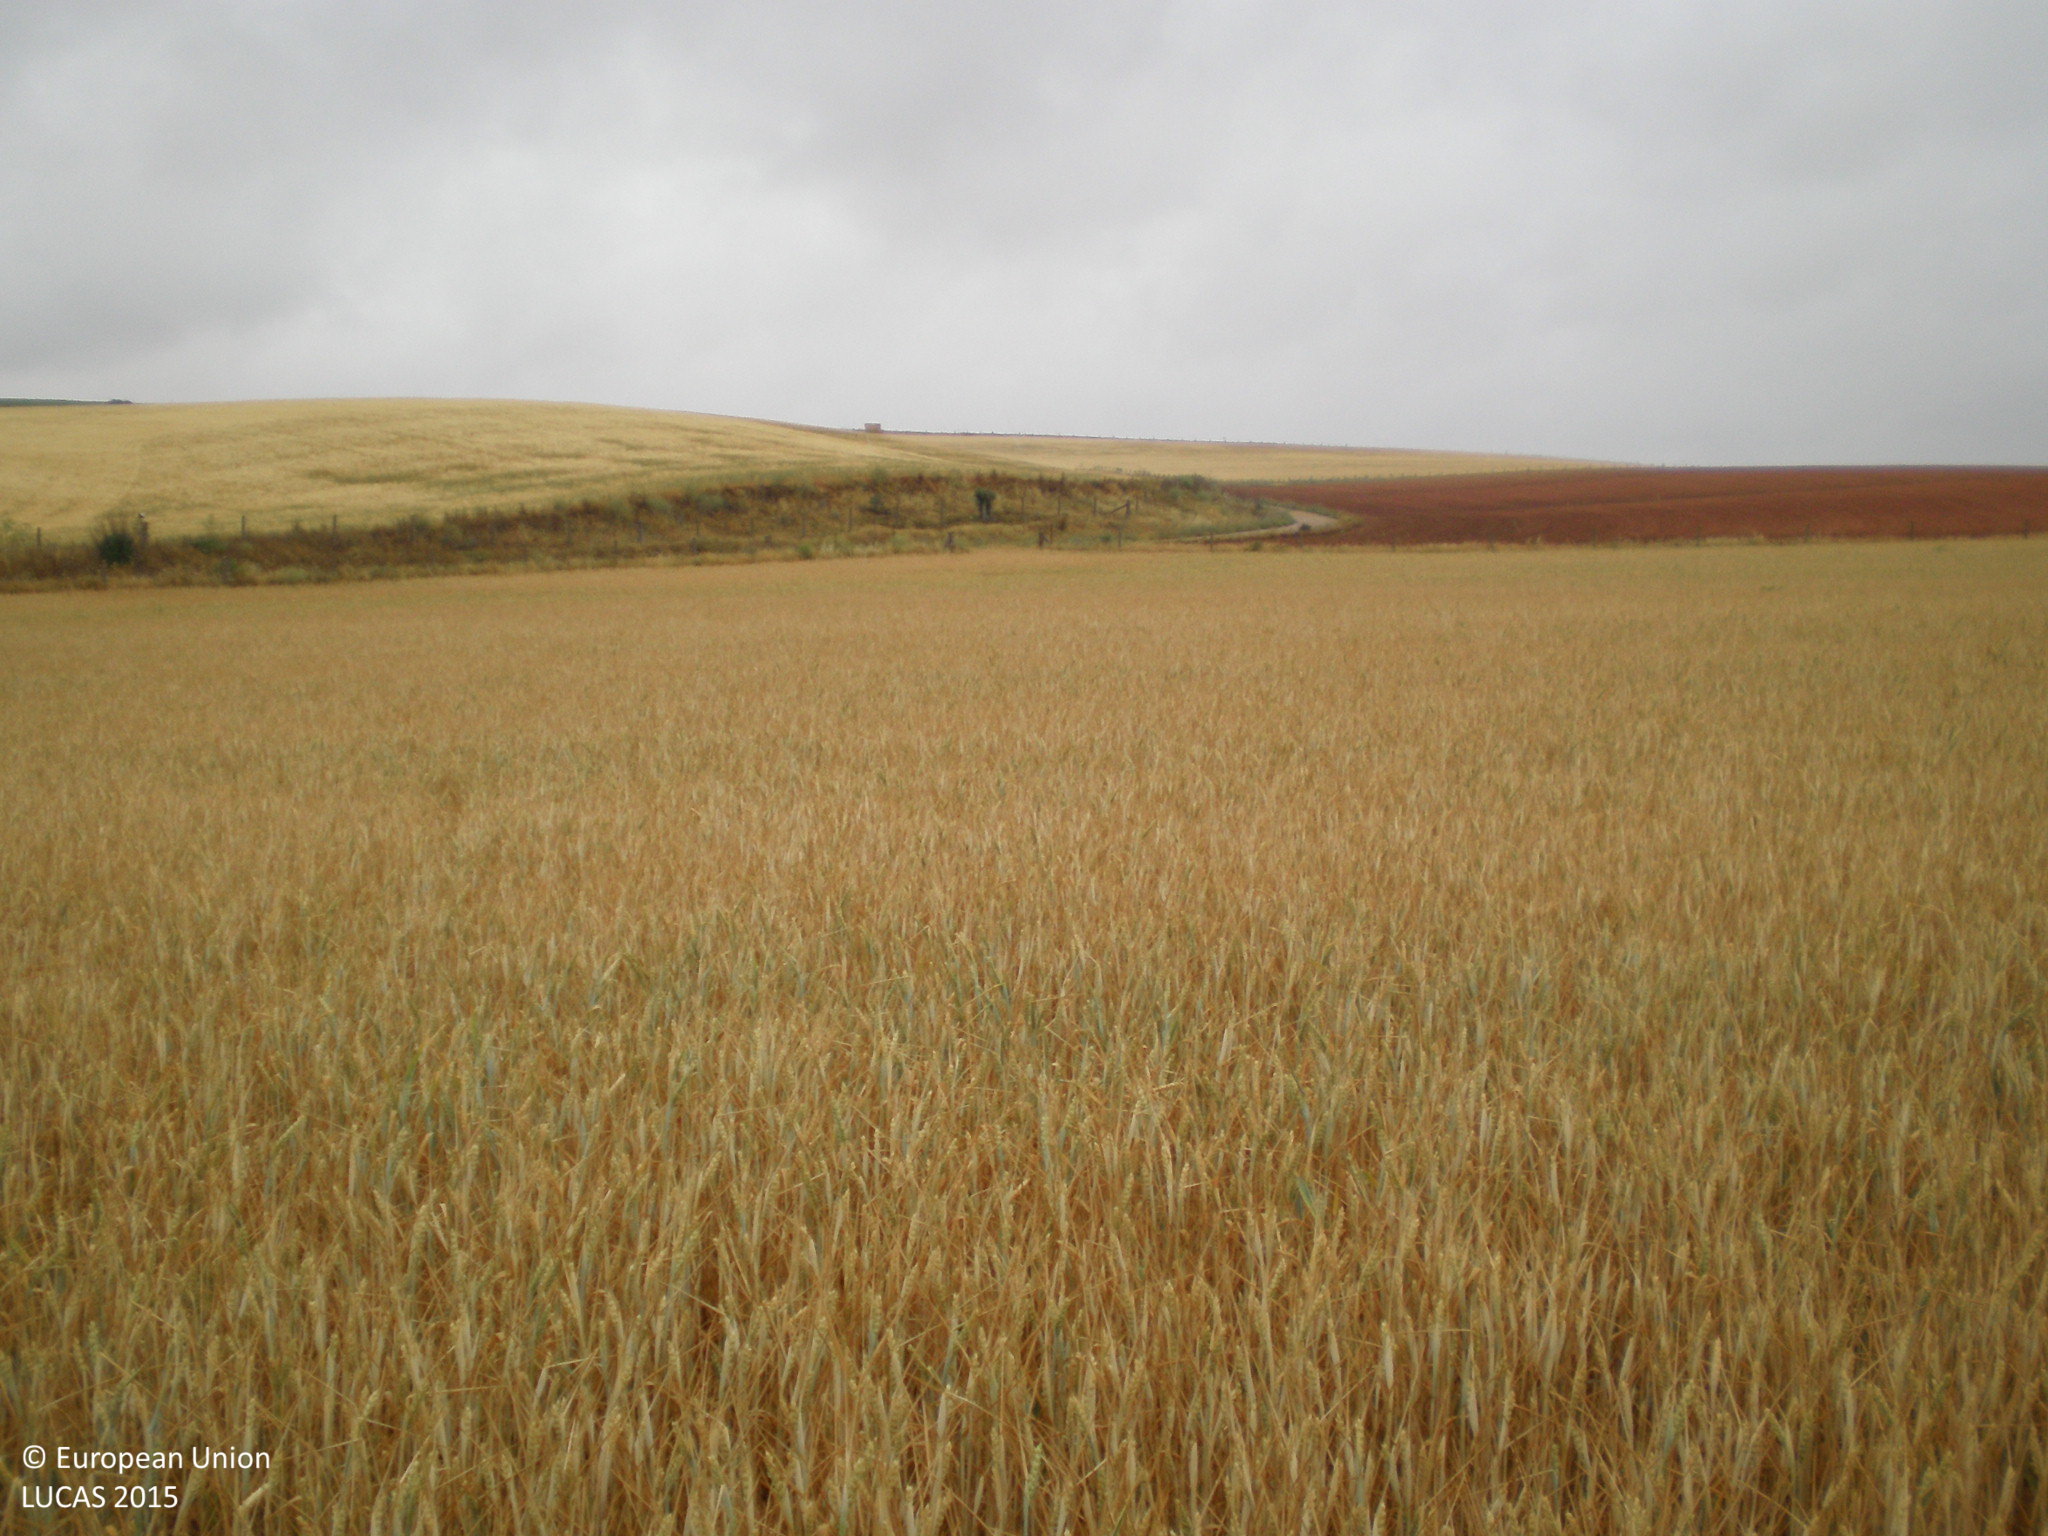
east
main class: Cropland
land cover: Common wheat
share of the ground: > 75 %
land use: Agriculture (excluding fallow land and kitchen gardens)
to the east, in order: Common wheat; Fences; Grass margins; Tracks; Grass margins; Fences; Grass margins; Barley
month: June
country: ES
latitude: 40.9714
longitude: -5.7532
